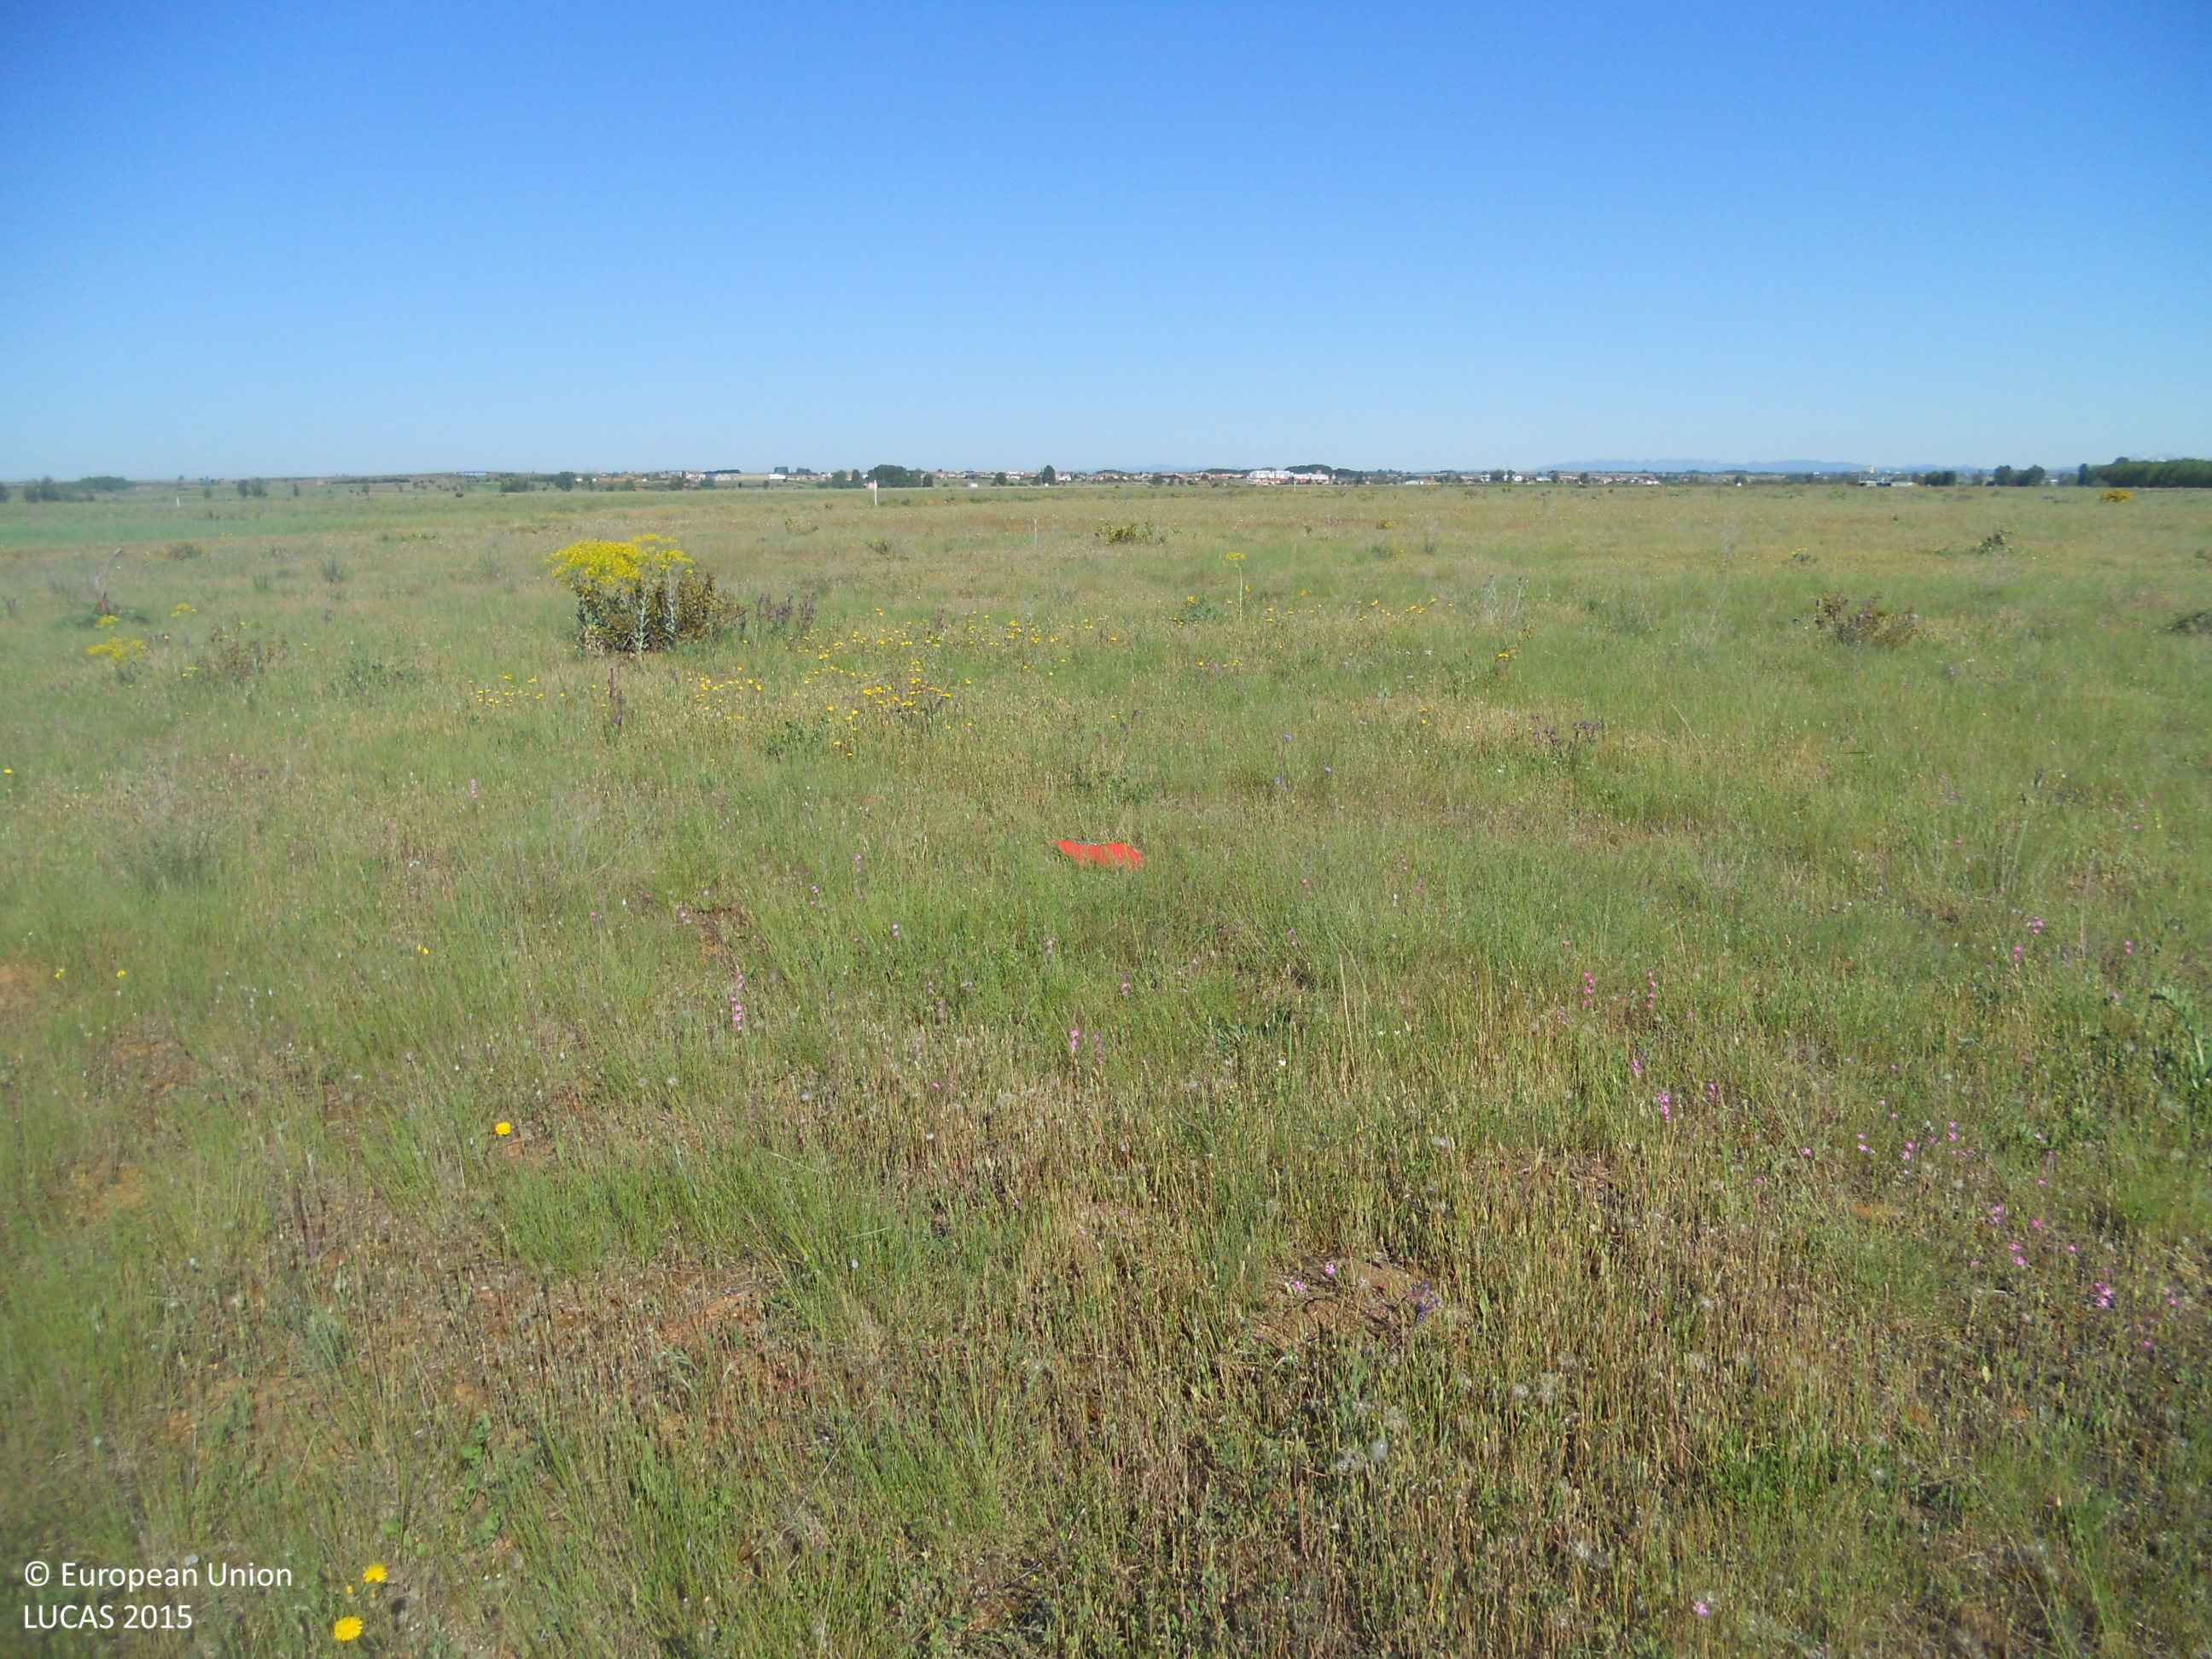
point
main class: Grassland
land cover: Spontaneously vegetated surfaces
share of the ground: > 75 %
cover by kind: herbaceous plants 100 %
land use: Fallow land
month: May
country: ES
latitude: 42.4718
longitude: -5.5545
